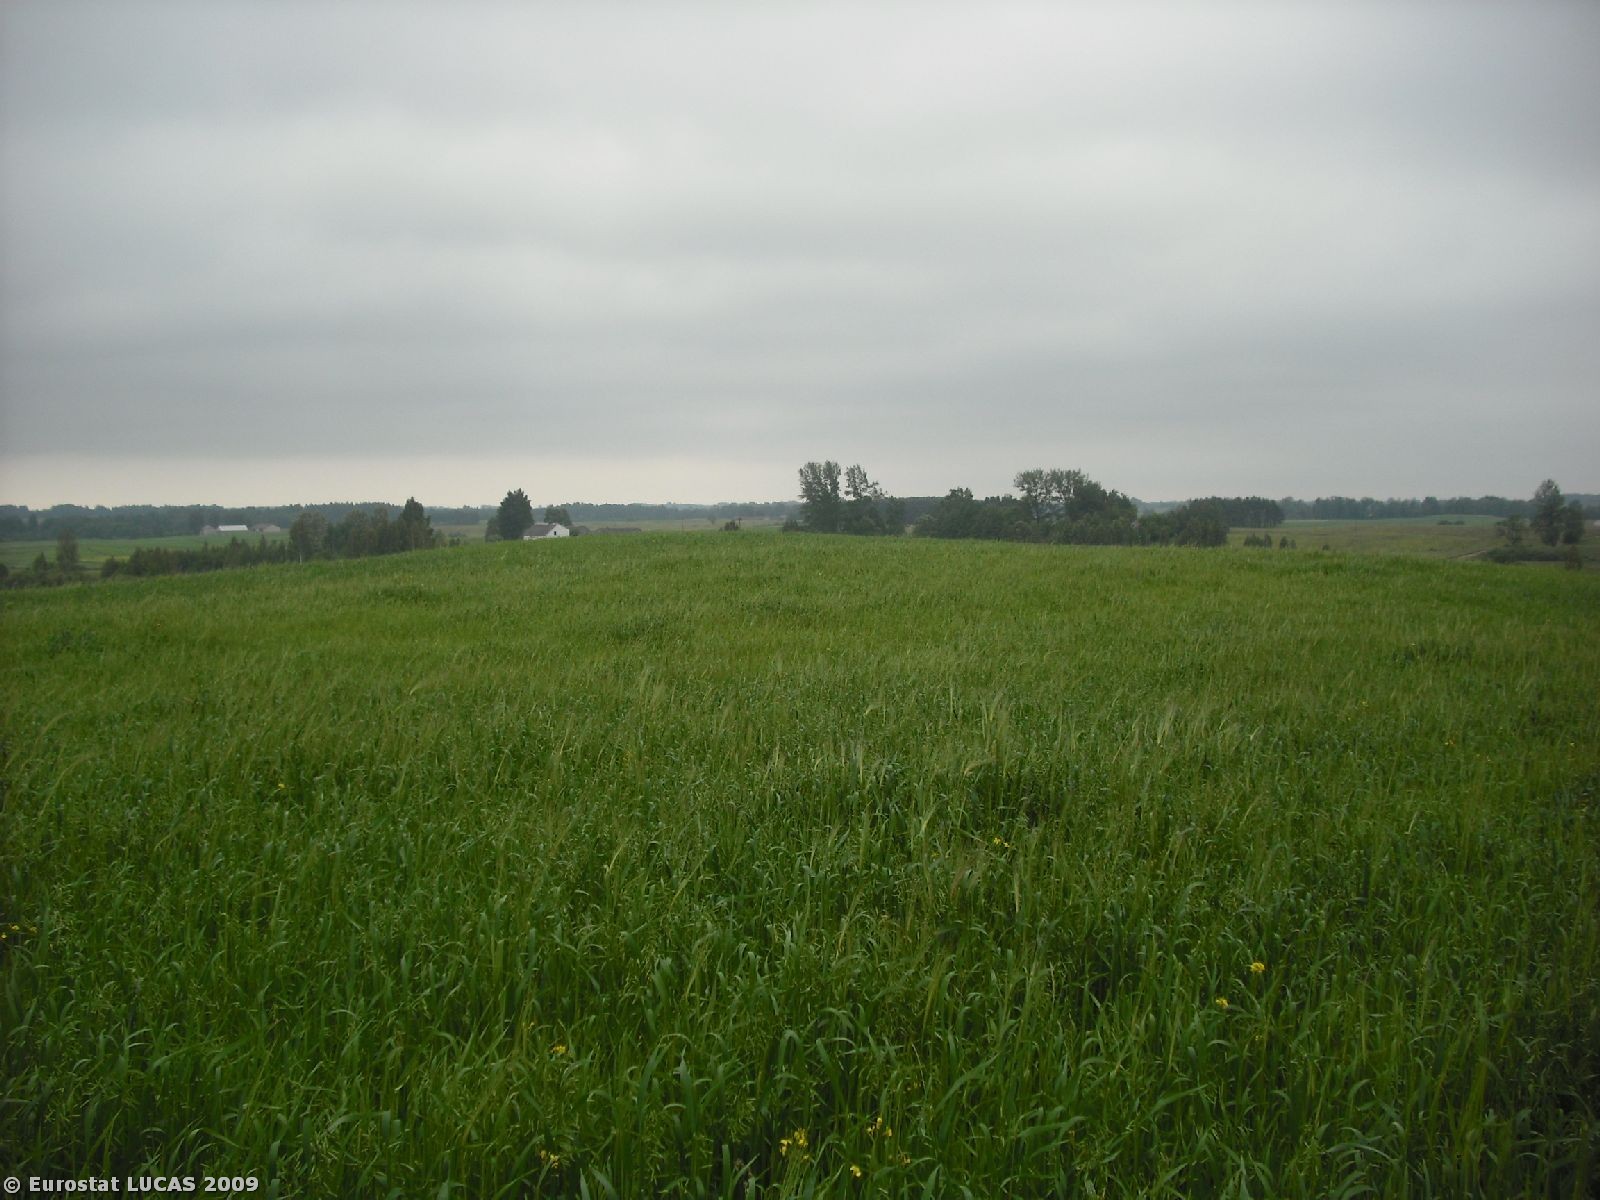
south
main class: Cropland
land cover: Oats
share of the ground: > 75 %
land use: Agriculture (excluding fallow land and kitchen gardens)
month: June
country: PL
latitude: 54.1026
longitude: 22.8092
